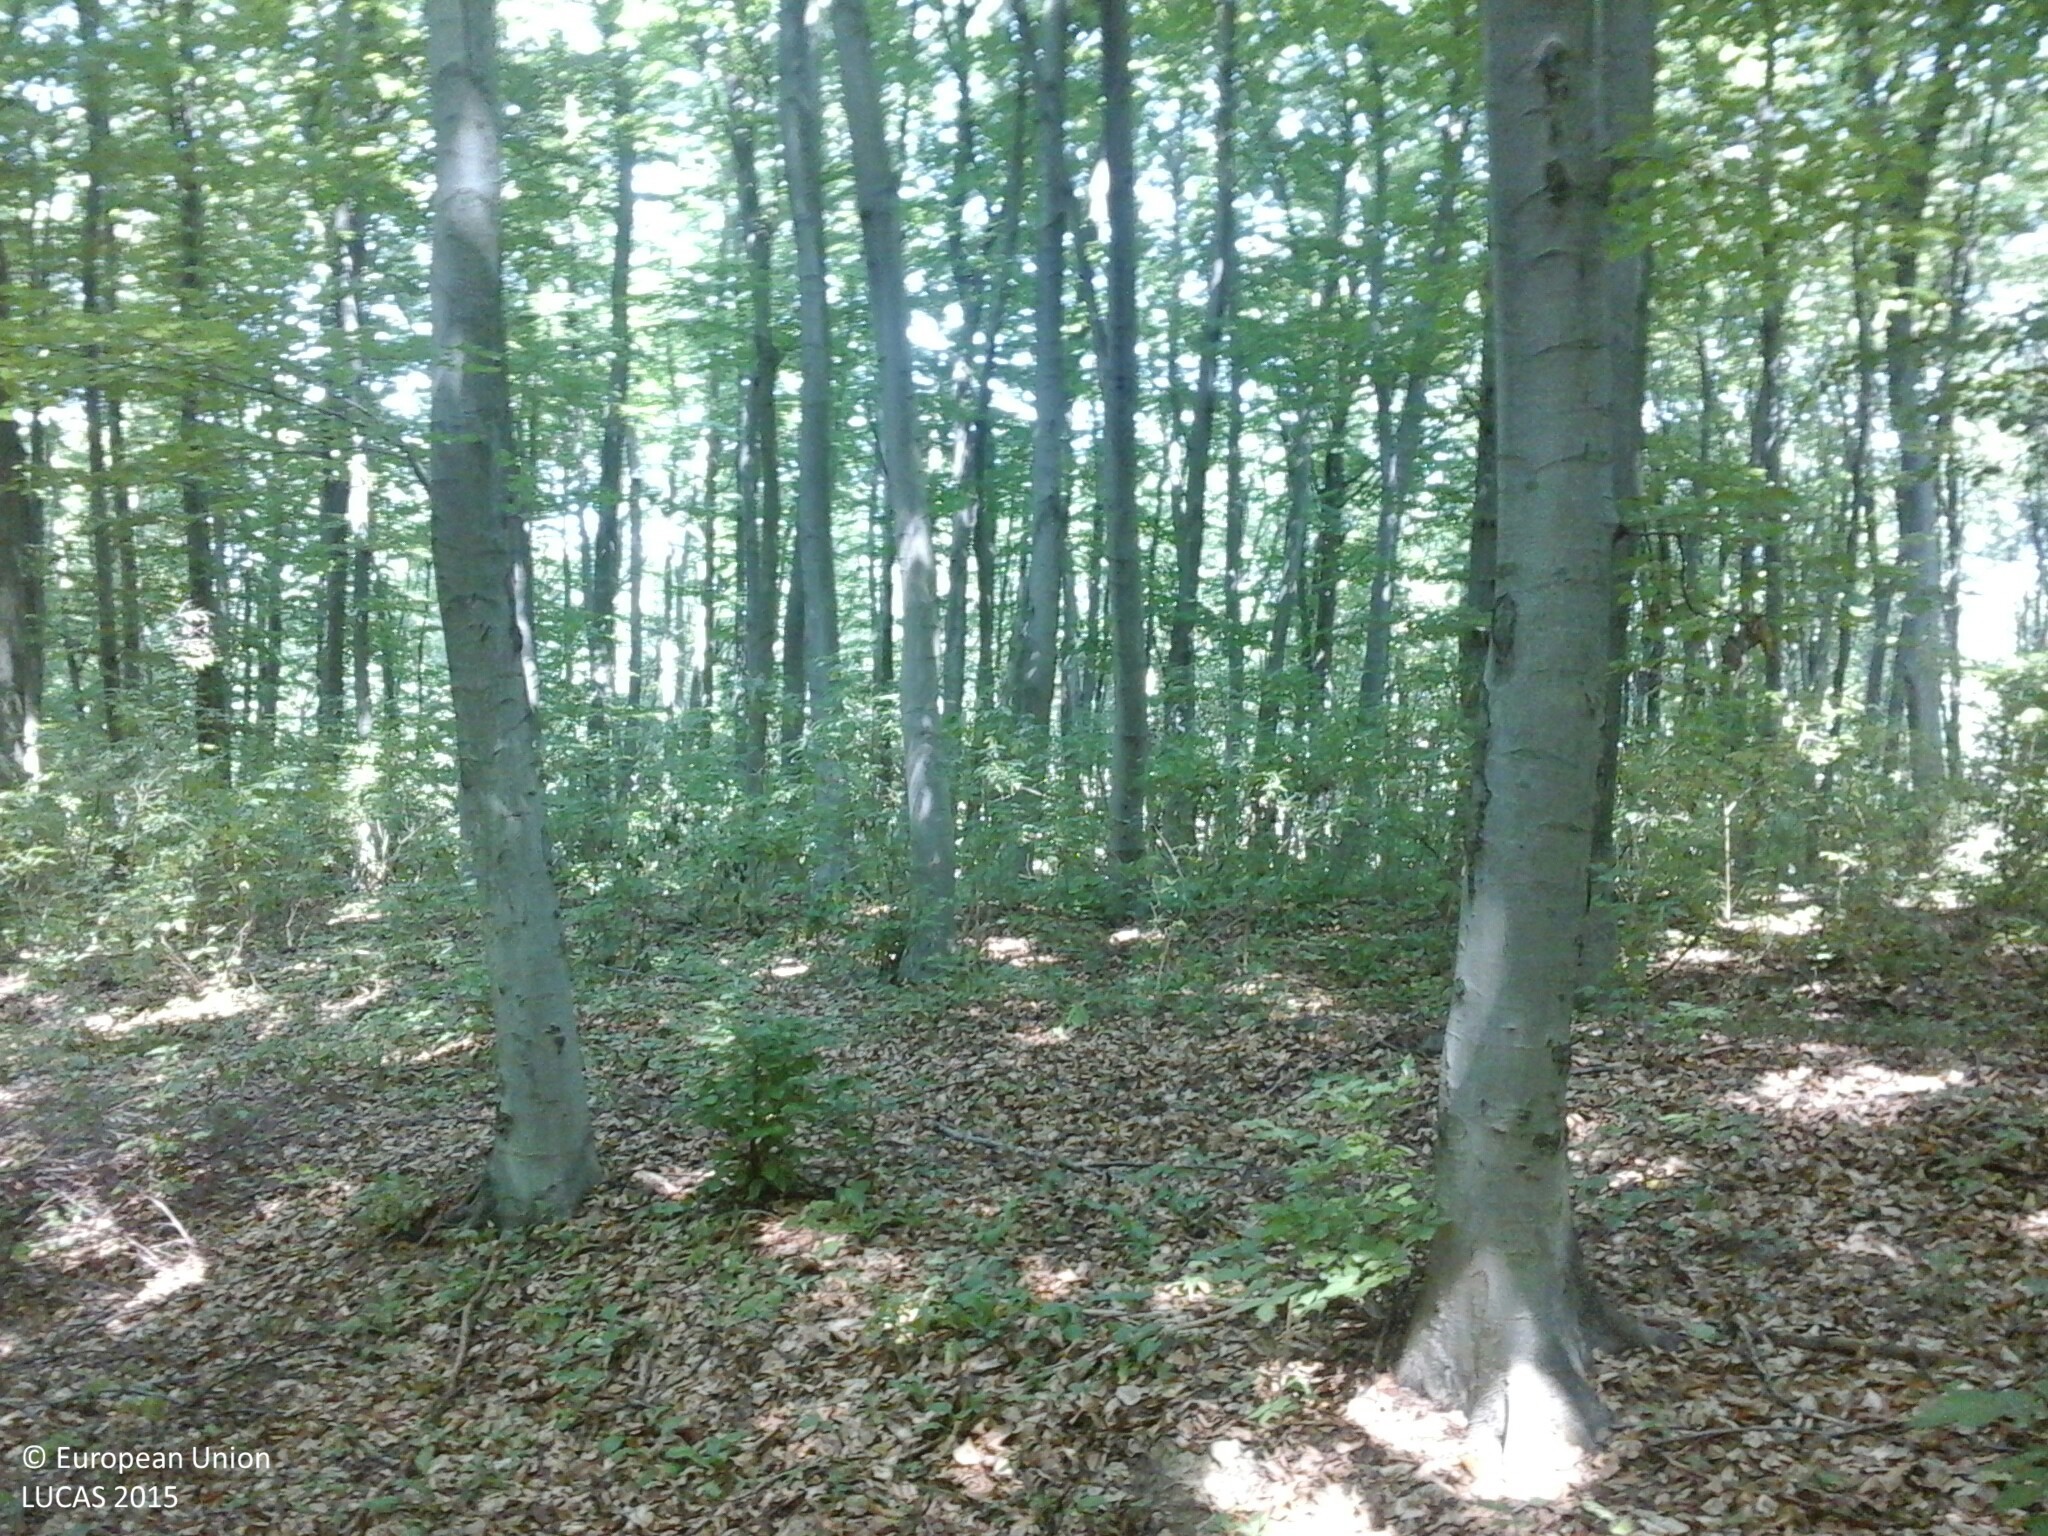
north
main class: Woodland
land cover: Broadleaved woodland
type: beech forest
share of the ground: > 75 %
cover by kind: broadleaved forest trees 100 %
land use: Forestry
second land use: Amenities, museums, leisure
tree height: > 5 m
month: August
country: HU
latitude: 47.3107
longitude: 18.0929
